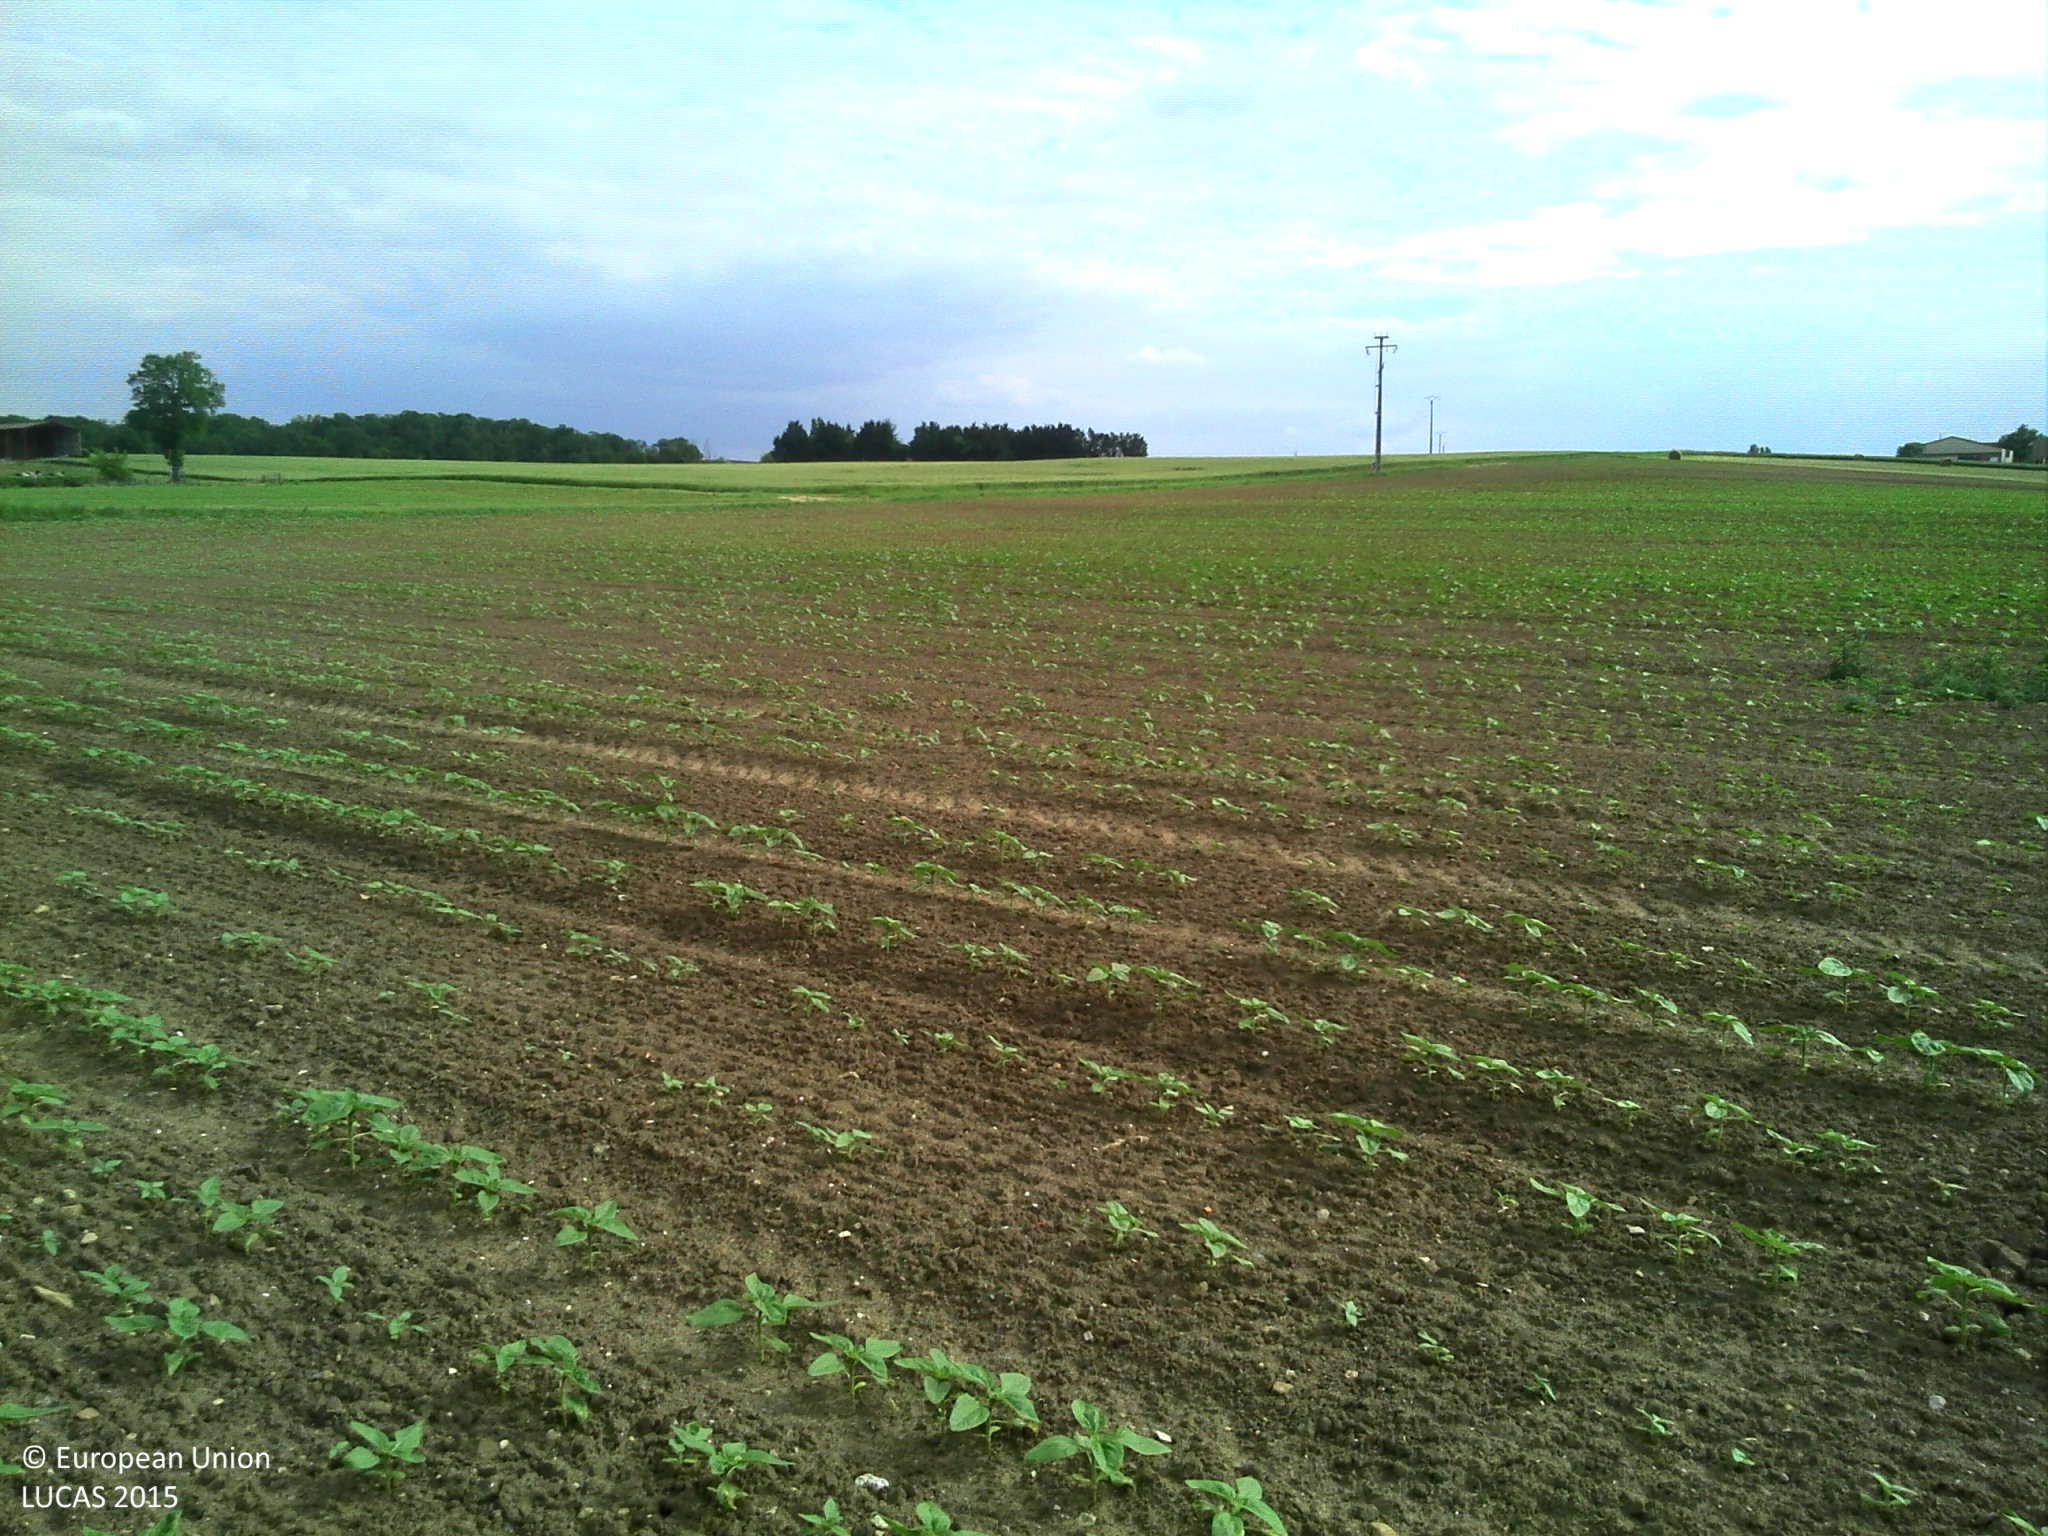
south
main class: Cropland
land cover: Sunflower
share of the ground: 10 - 25 %
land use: Agriculture (excluding fallow land and kitchen gardens)
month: May
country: FR
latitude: 46.8286
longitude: 0.2387
